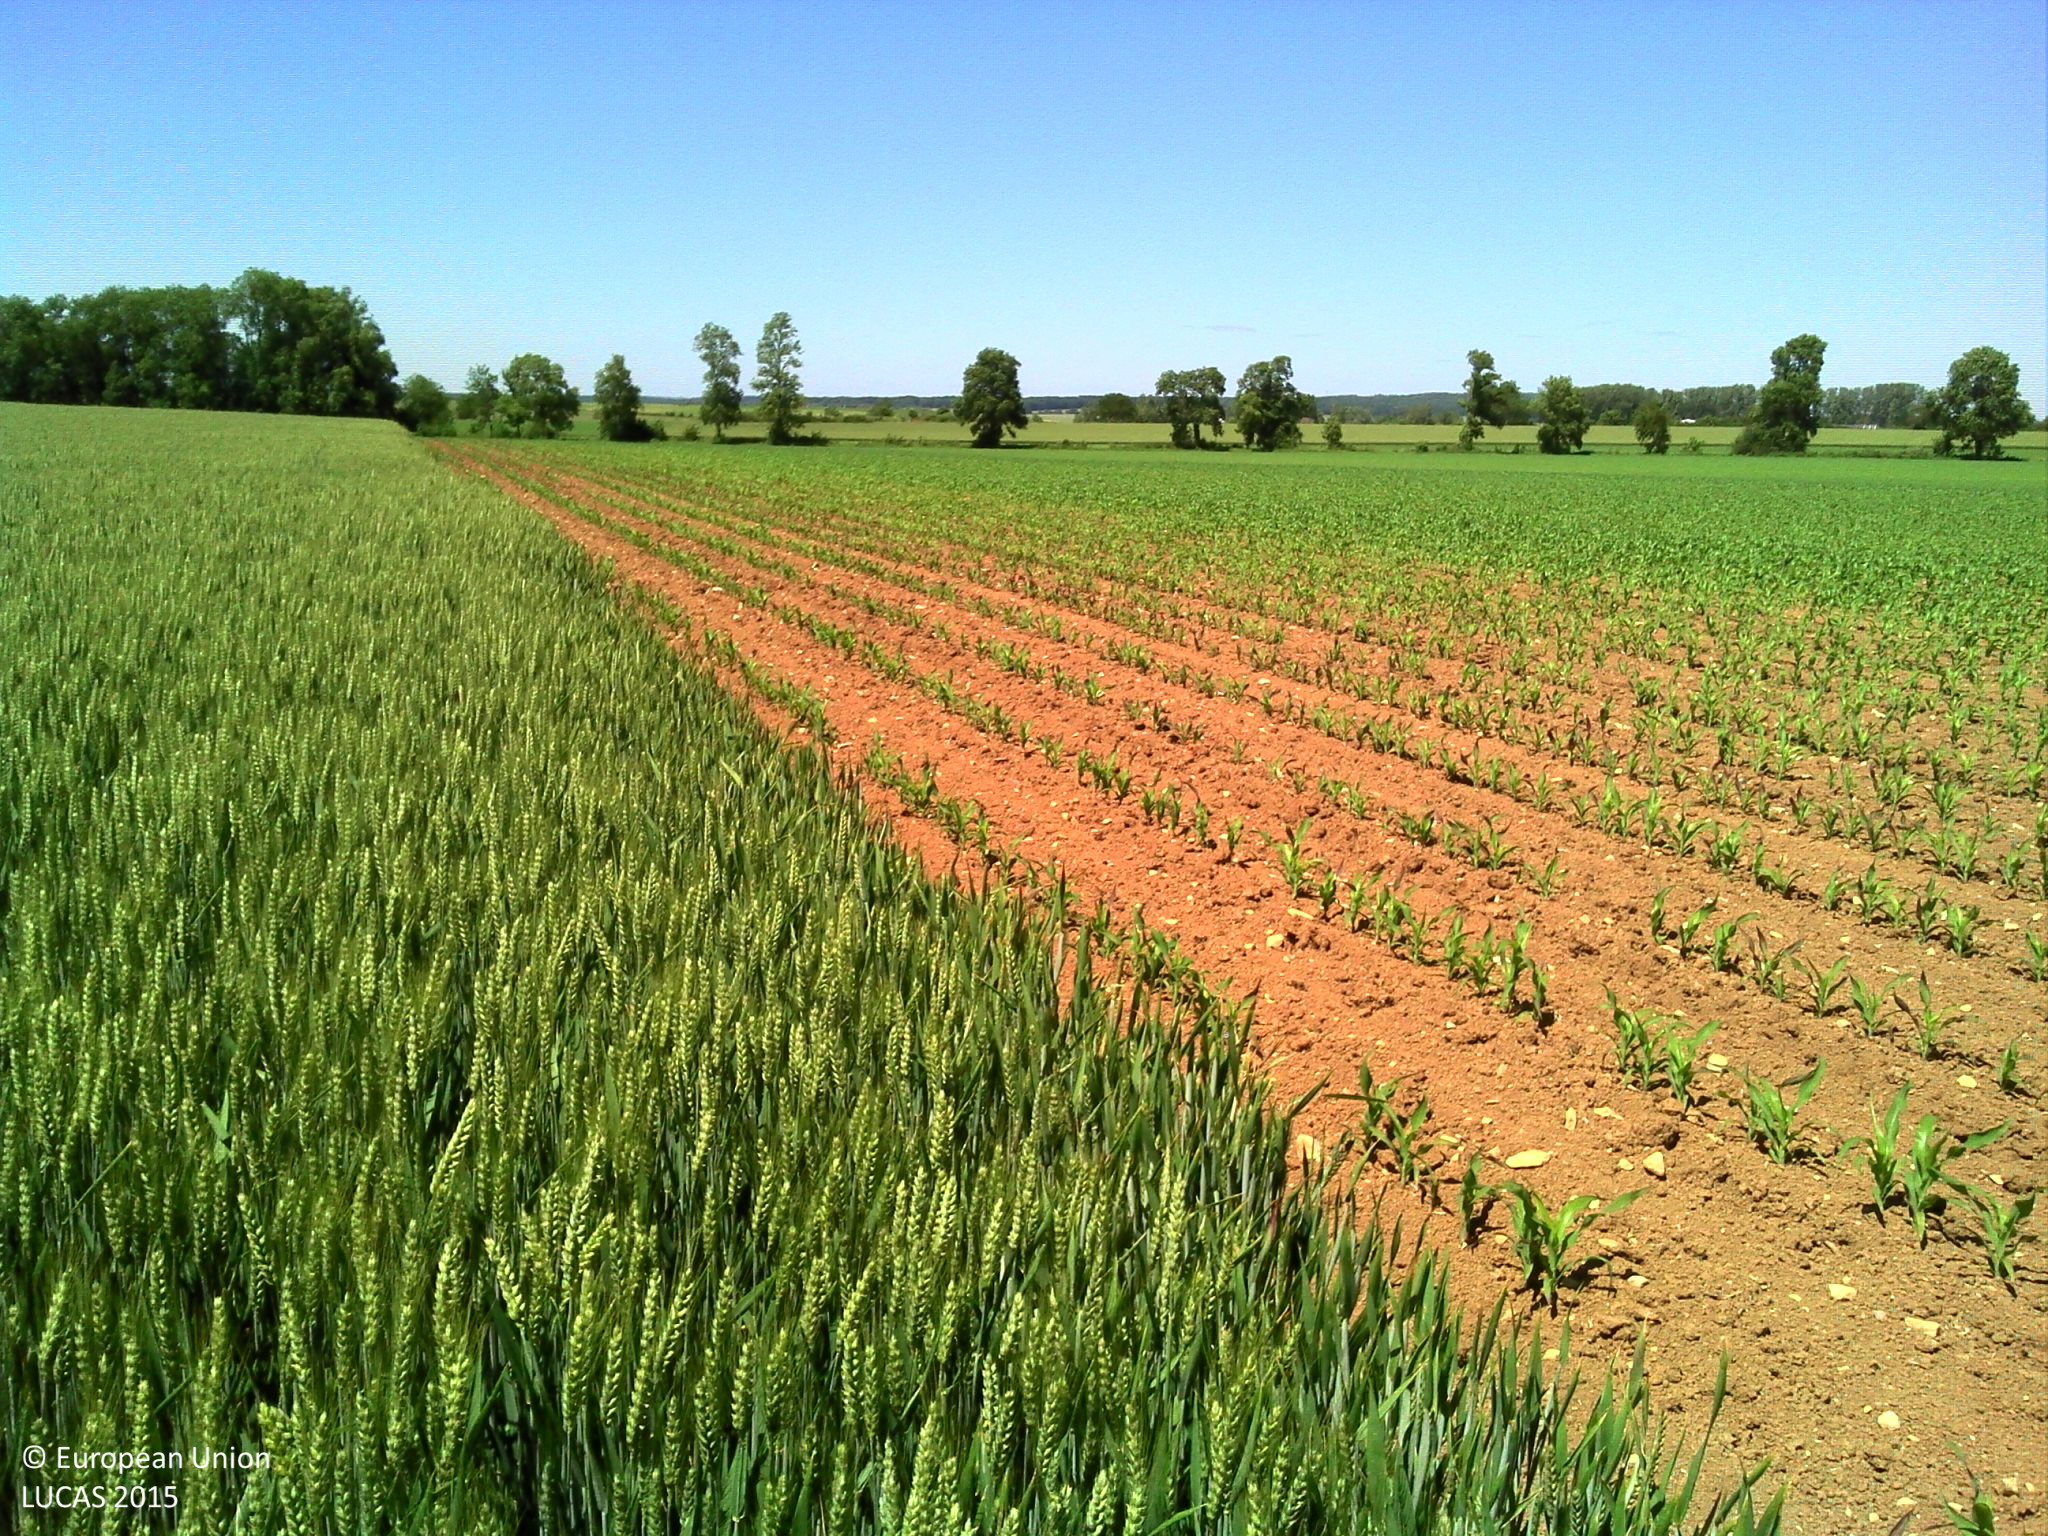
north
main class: Cropland
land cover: Durum wheat
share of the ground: > 75 %
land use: Agriculture (excluding fallow land and kitchen gardens)
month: June
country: FR
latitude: 47.0786
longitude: 2.7110
